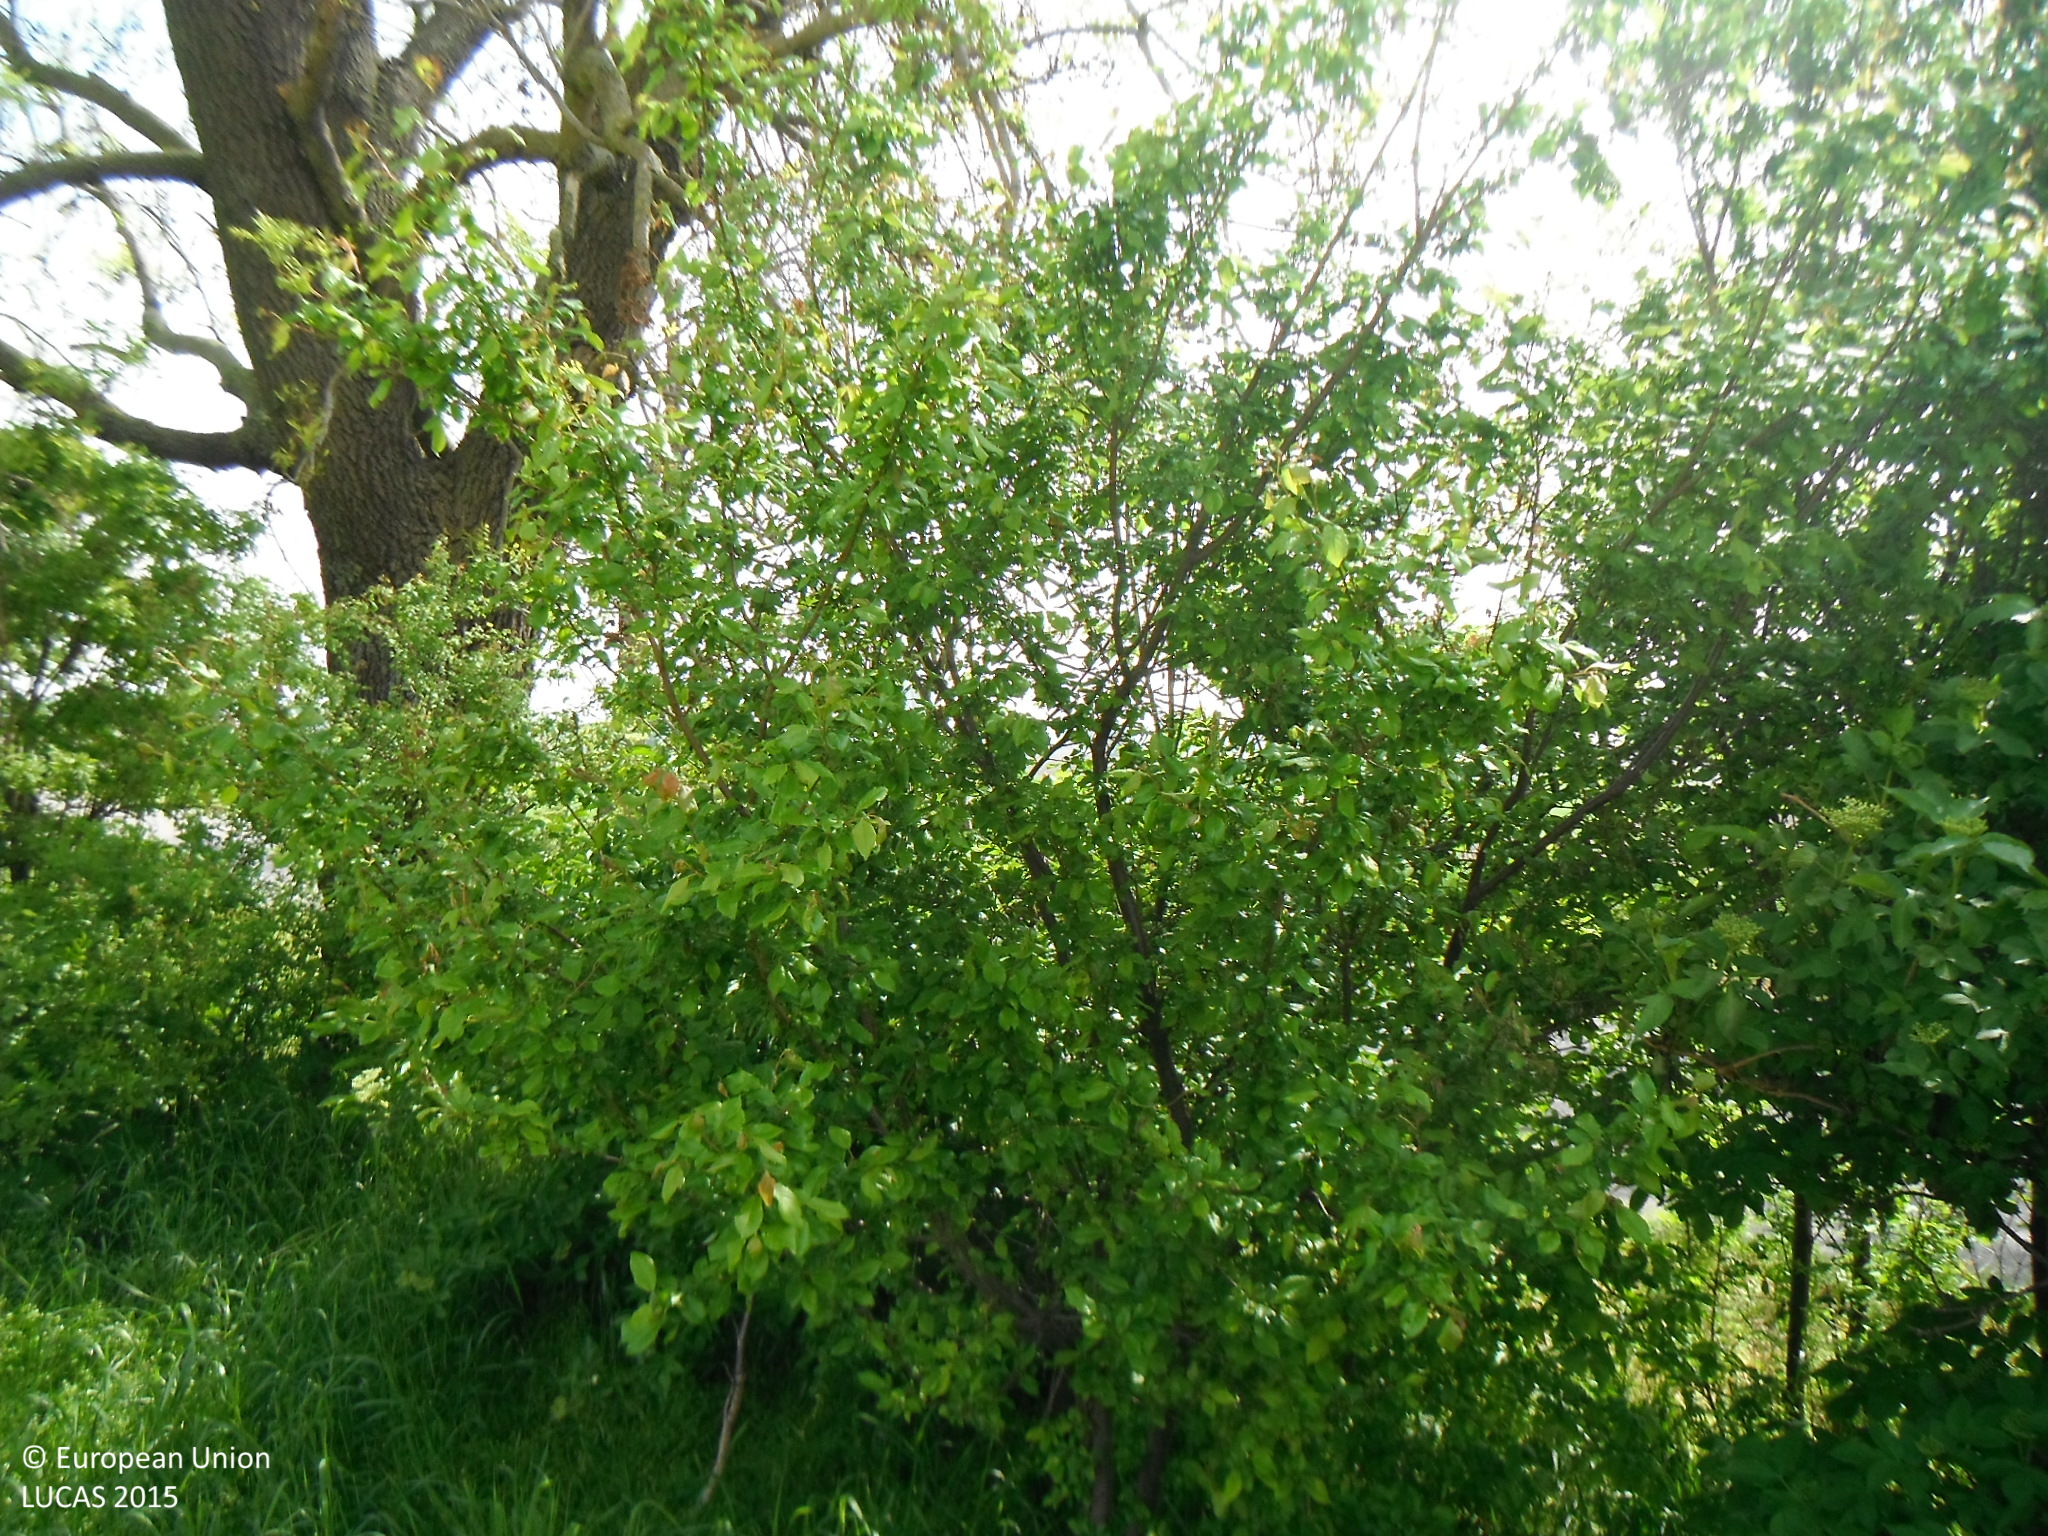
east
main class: Cropland
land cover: Rape and turnip rape
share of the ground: > 75 %
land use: Agriculture (excluding fallow land and kitchen gardens)
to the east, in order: Rape and turnip rape
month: May
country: SK
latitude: 48.0523
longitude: 17.3205
